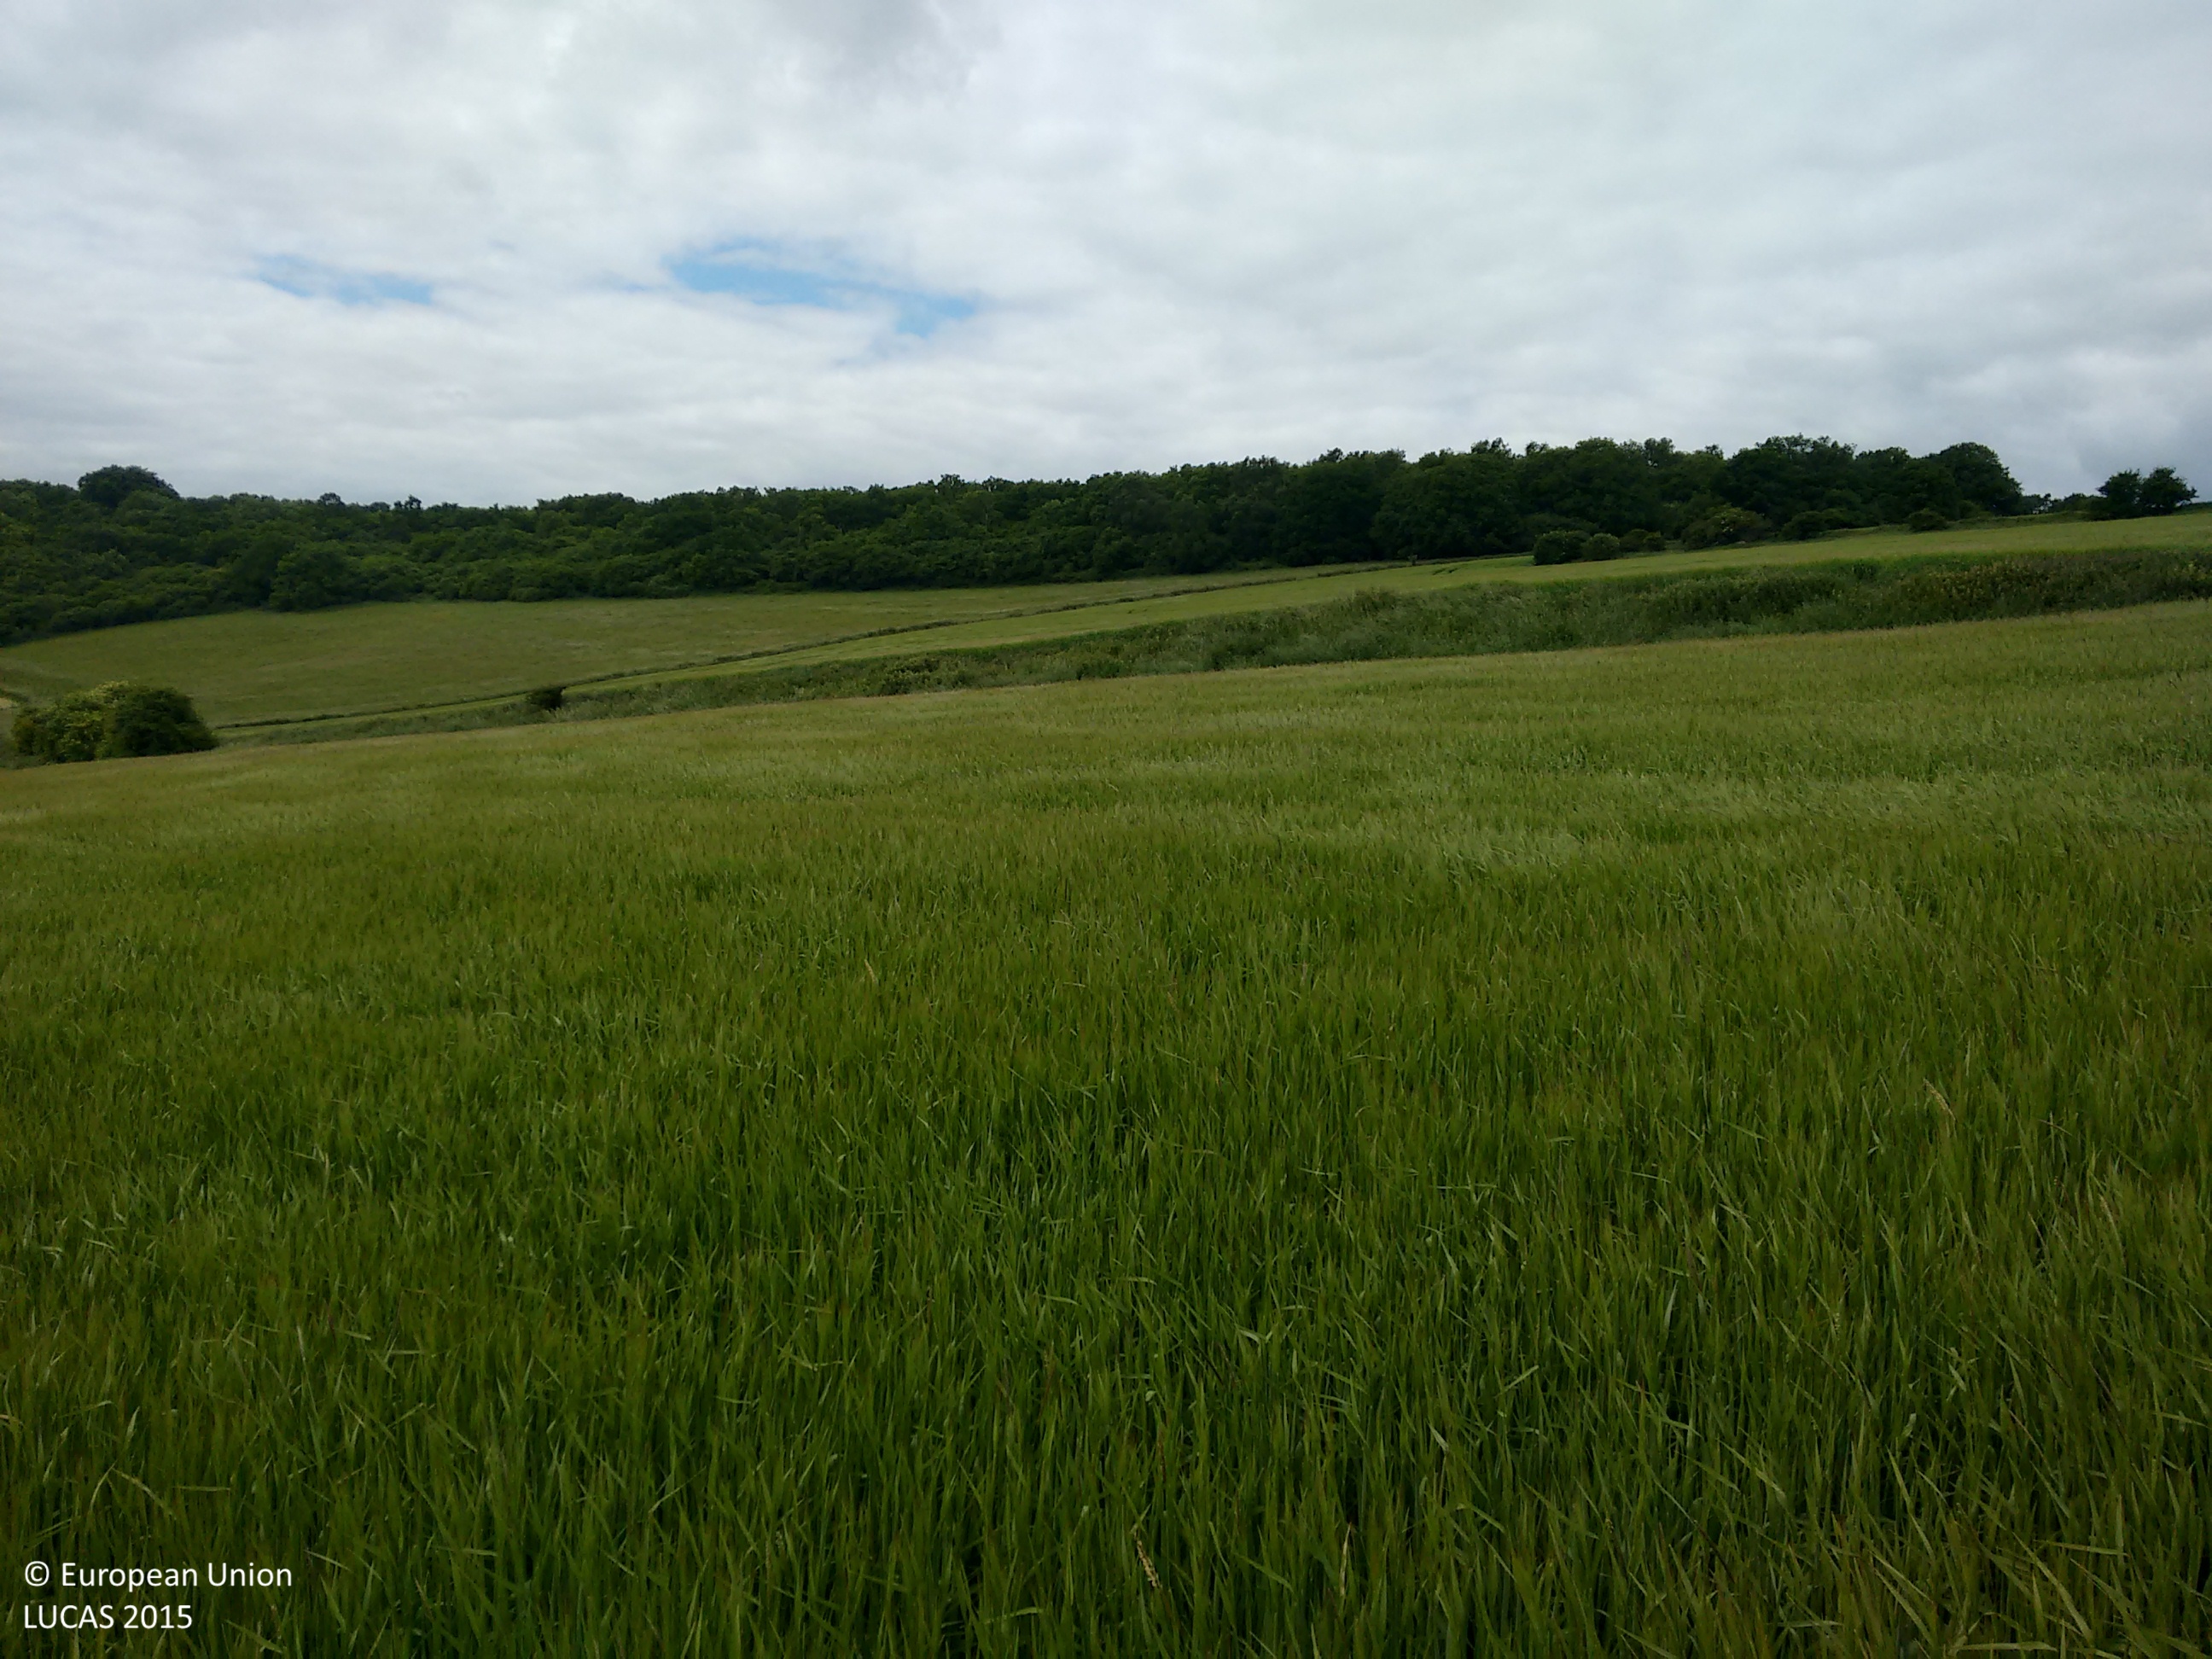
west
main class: Cropland
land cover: Barley
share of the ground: > 75 %
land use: Agriculture (excluding fallow land and kitchen gardens)
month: June
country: GB
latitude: 51.1188
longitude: -1.9293
